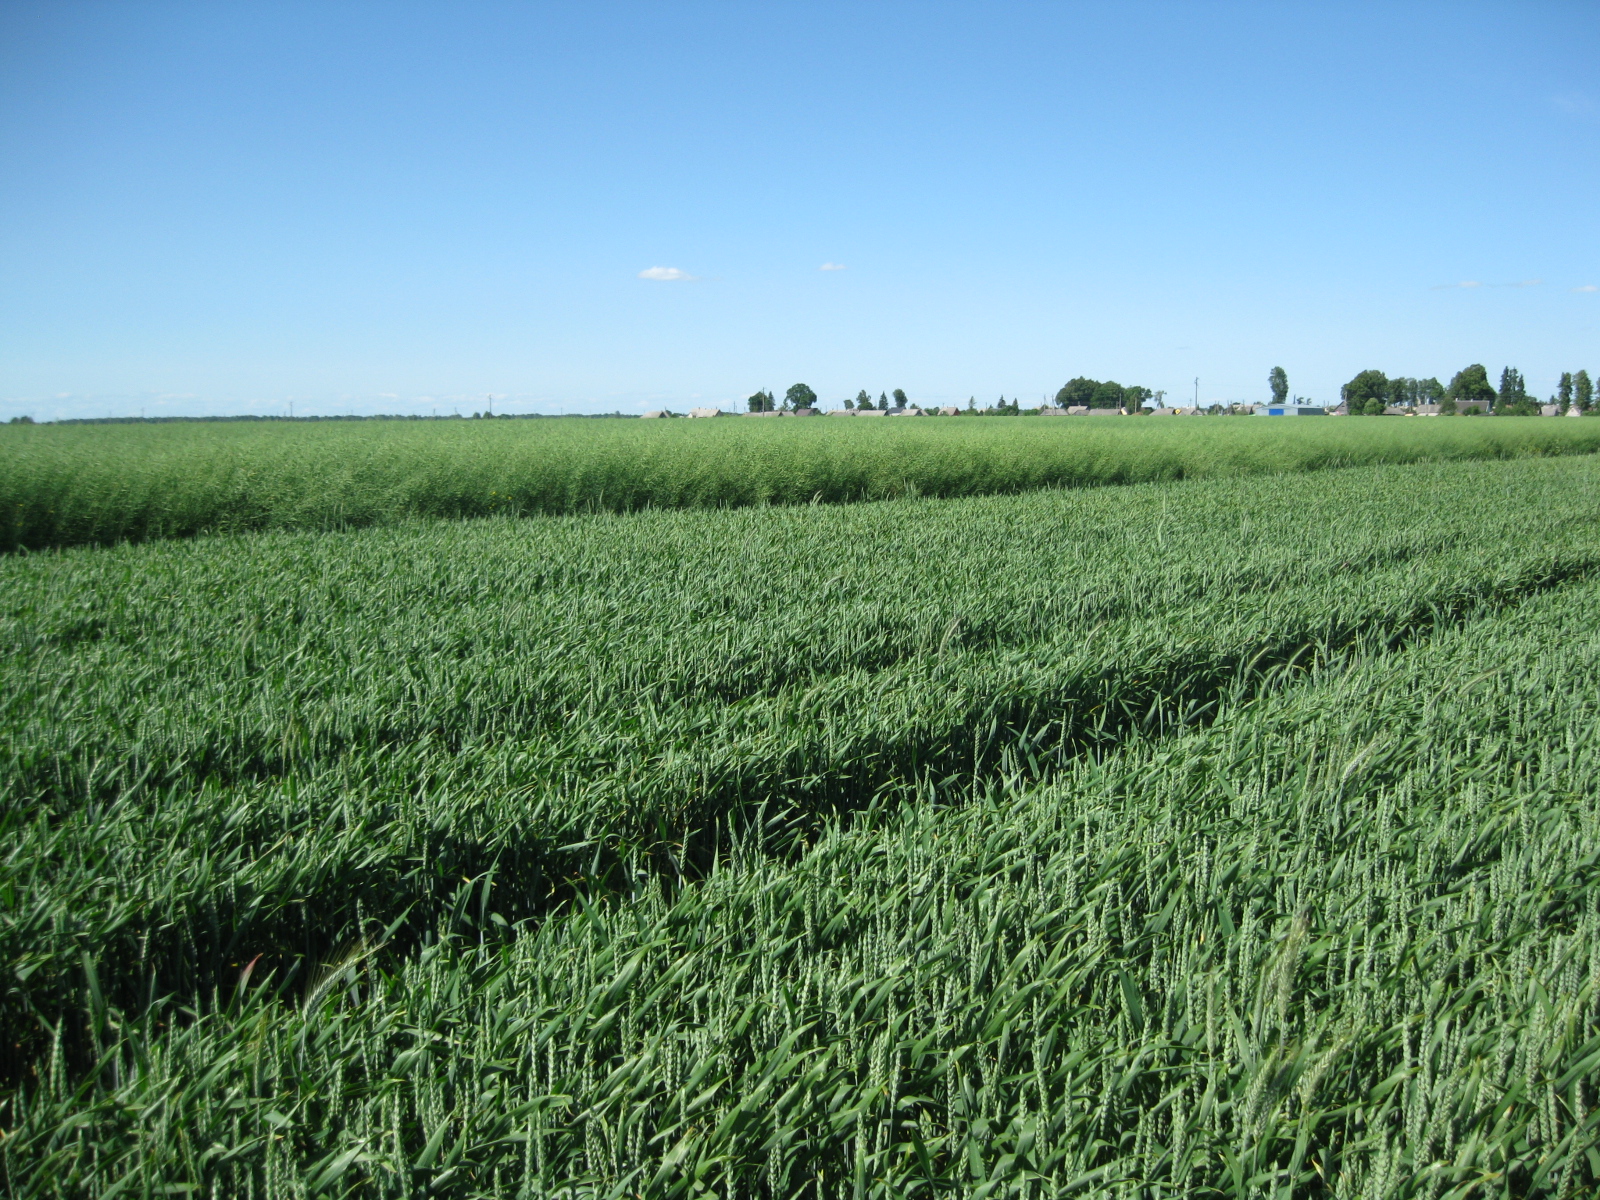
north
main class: Cropland
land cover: Common wheat
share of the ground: > 75 %
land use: Agriculture (excluding fallow land and kitchen gardens)
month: June
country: LT
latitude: 55.2557
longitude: 23.7893
